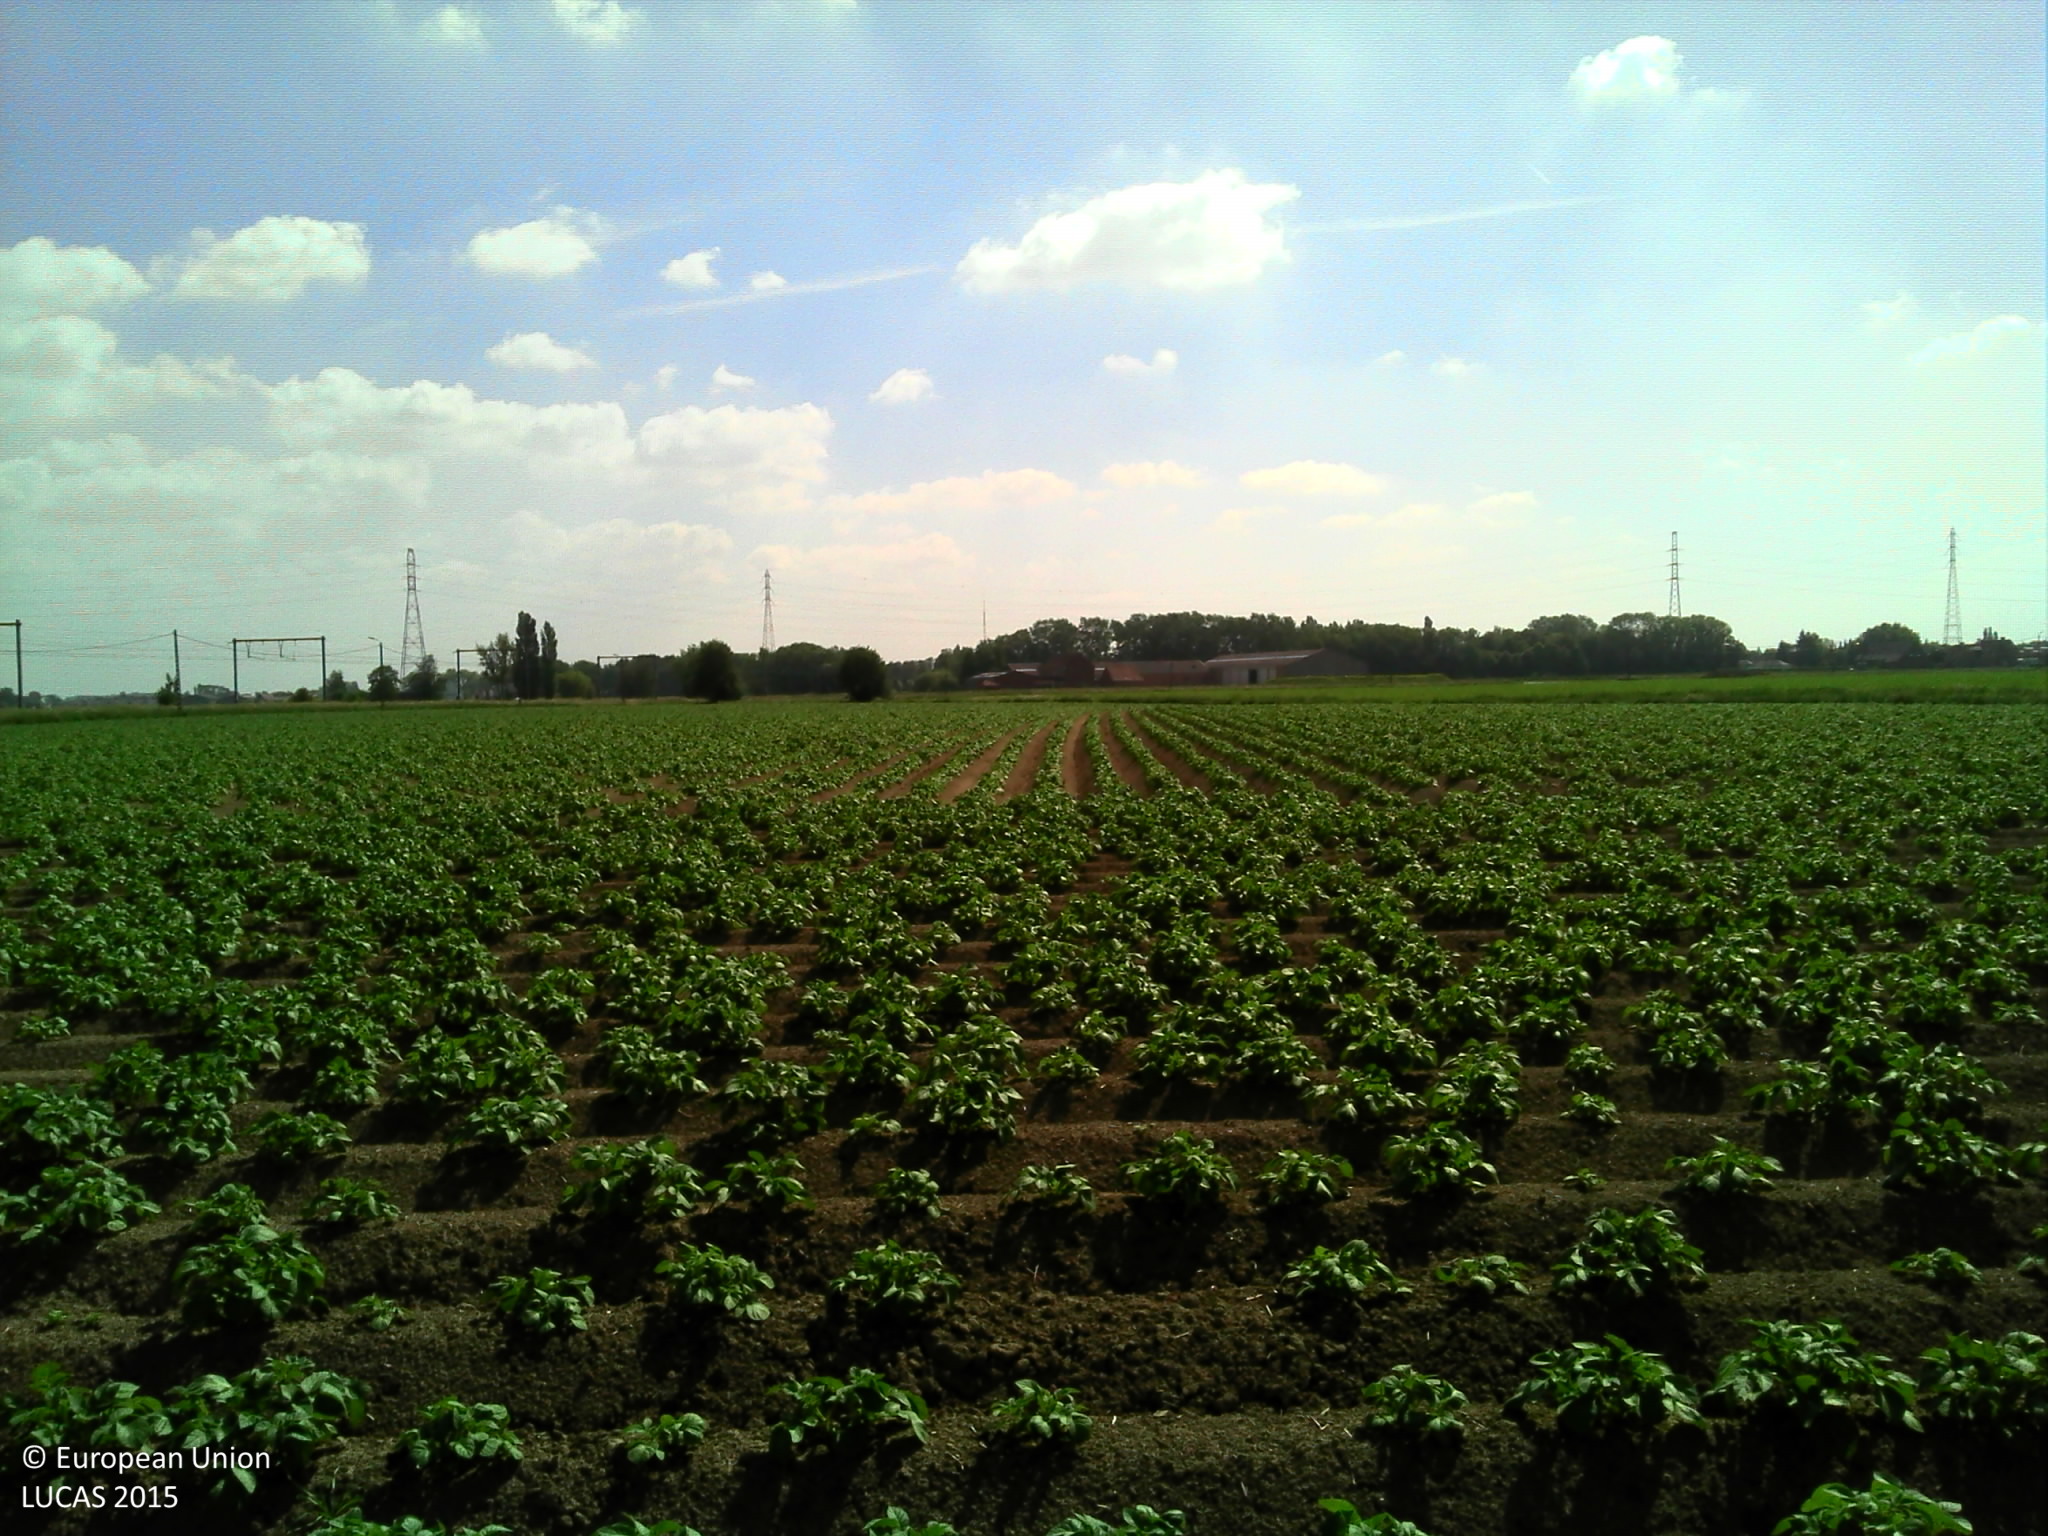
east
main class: Cropland
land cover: Potatoes
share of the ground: 10 - 25 %
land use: Agriculture (excluding fallow land and kitchen gardens)
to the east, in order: Potatoes; Grass margins; Ditches and canals; Grass margins; Sugar beet
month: June
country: BE
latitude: 50.8075
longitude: 3.1364
